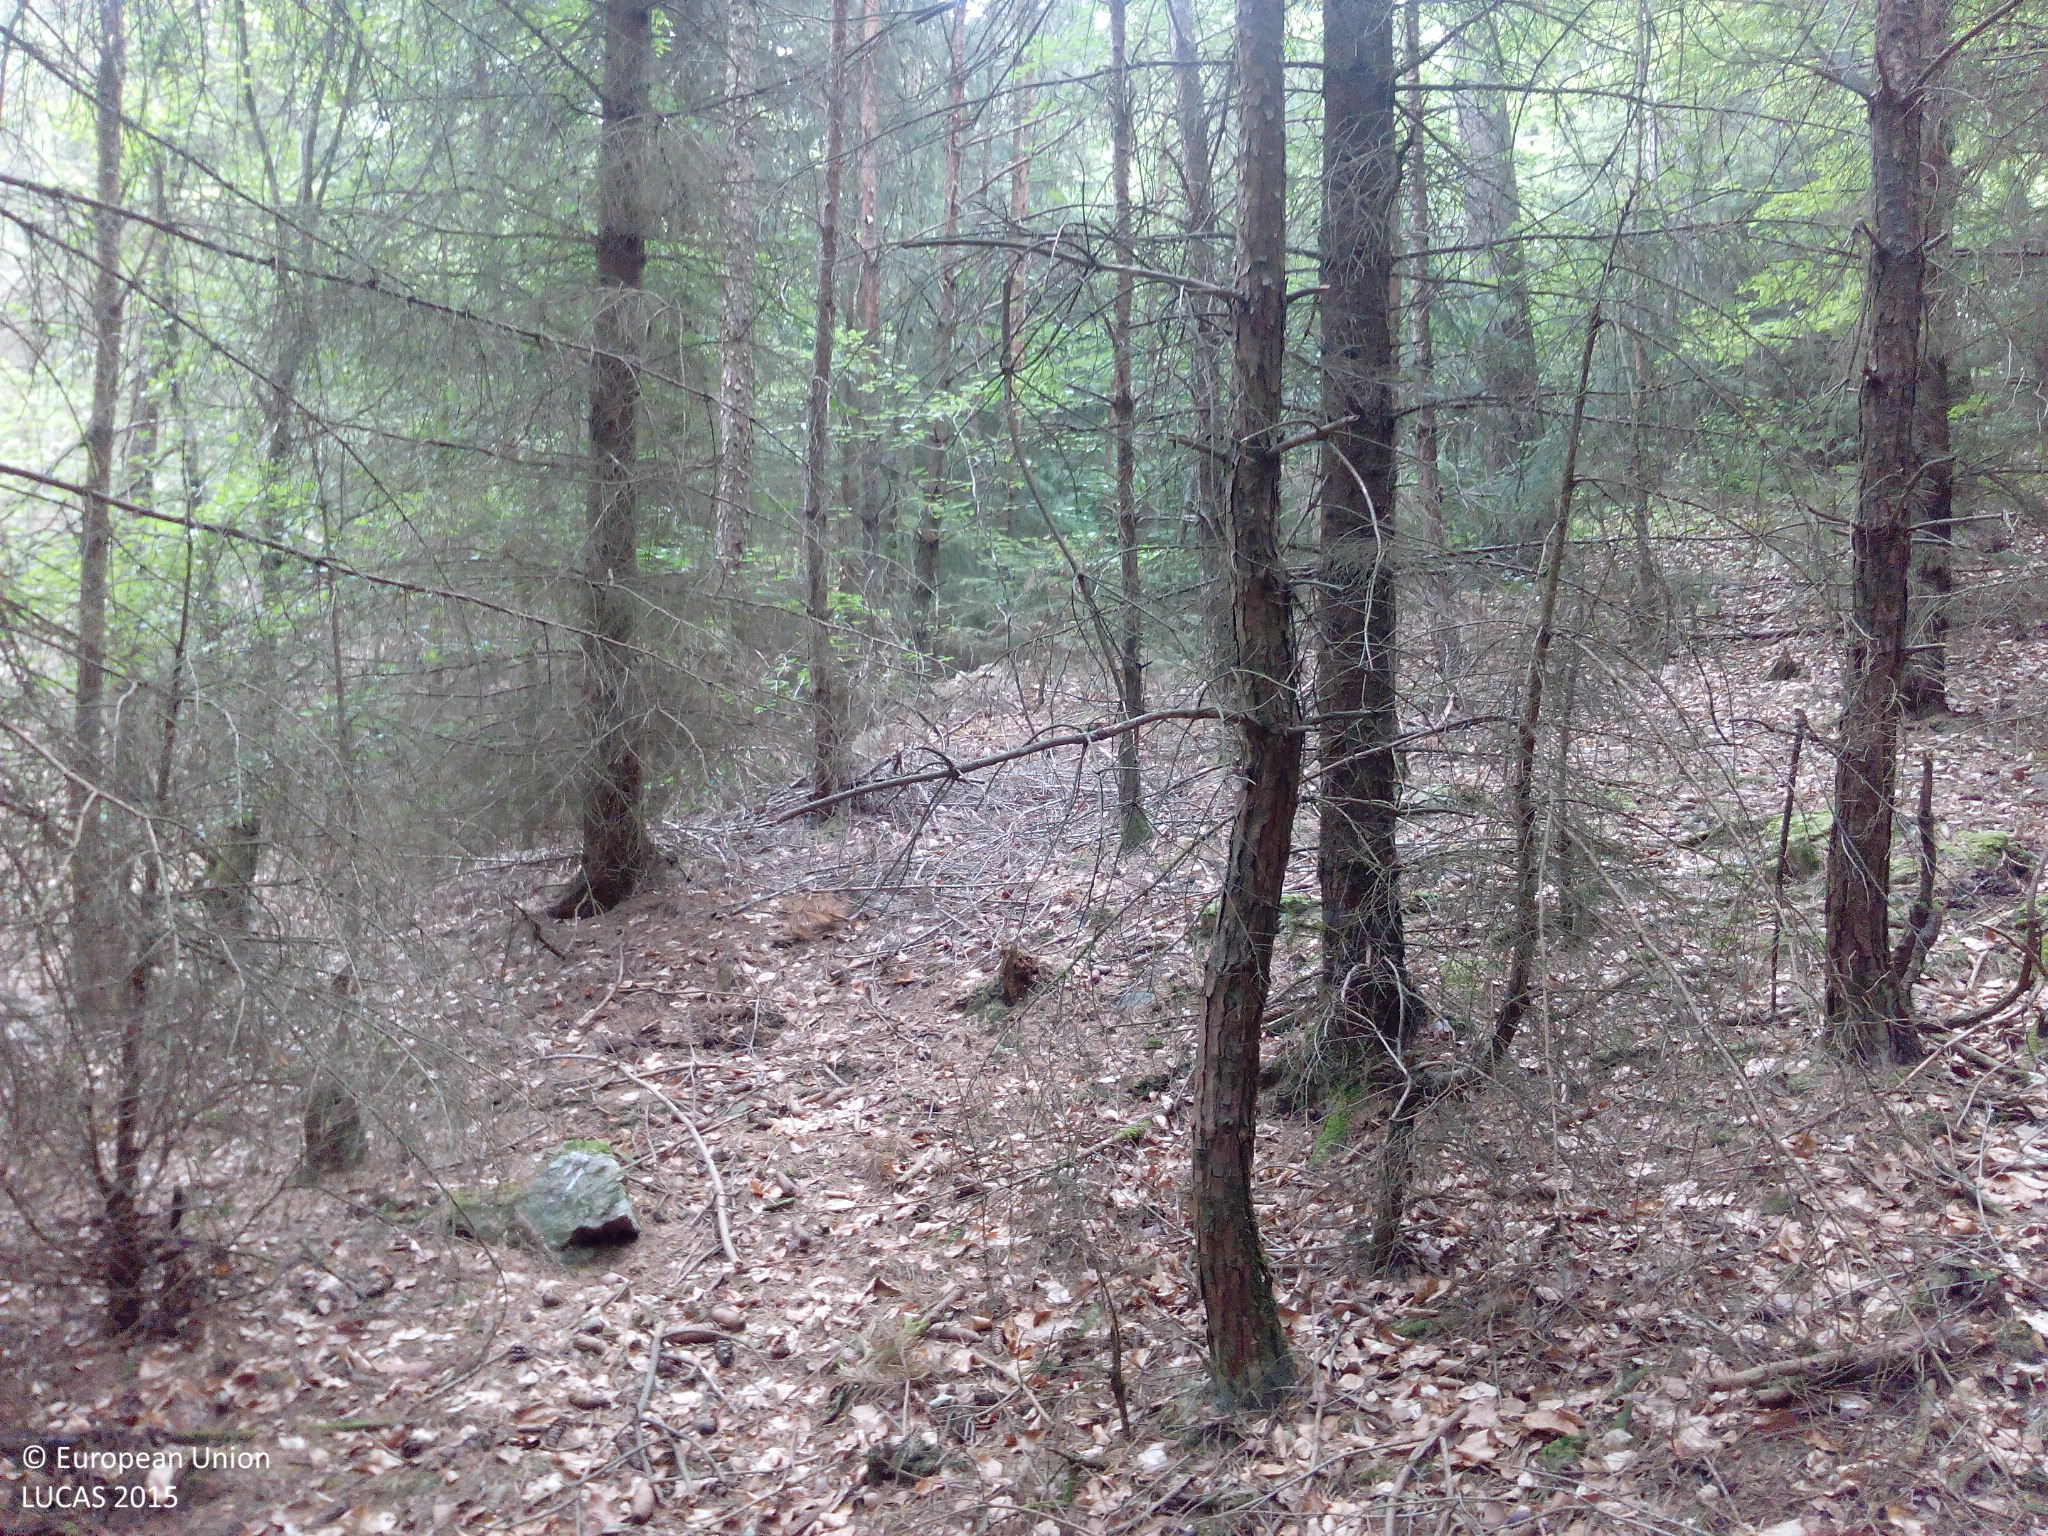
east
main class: Woodland
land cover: Other mixed woodland
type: hemiboreal forest and nemoral coniferous forest and mixed broadleaved-coniferous forest
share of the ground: > 75 %
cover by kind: coniferous forest trees 55 %, broadleaved forest trees 30 %, unconsolidated bare surface 10 %, lichens and mosses 5 %
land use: Forestry
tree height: > 5 m
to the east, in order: Other mixed woodland; Pine dominated mixed woodland; Ditches and canals; Pine dominated mixed woodland; Other mixed woodland; Tracks; Spruce dominated mixed woodland; Spruce dominated coniferous woodland
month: July
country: DE
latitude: 49.9058
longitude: 7.5358
